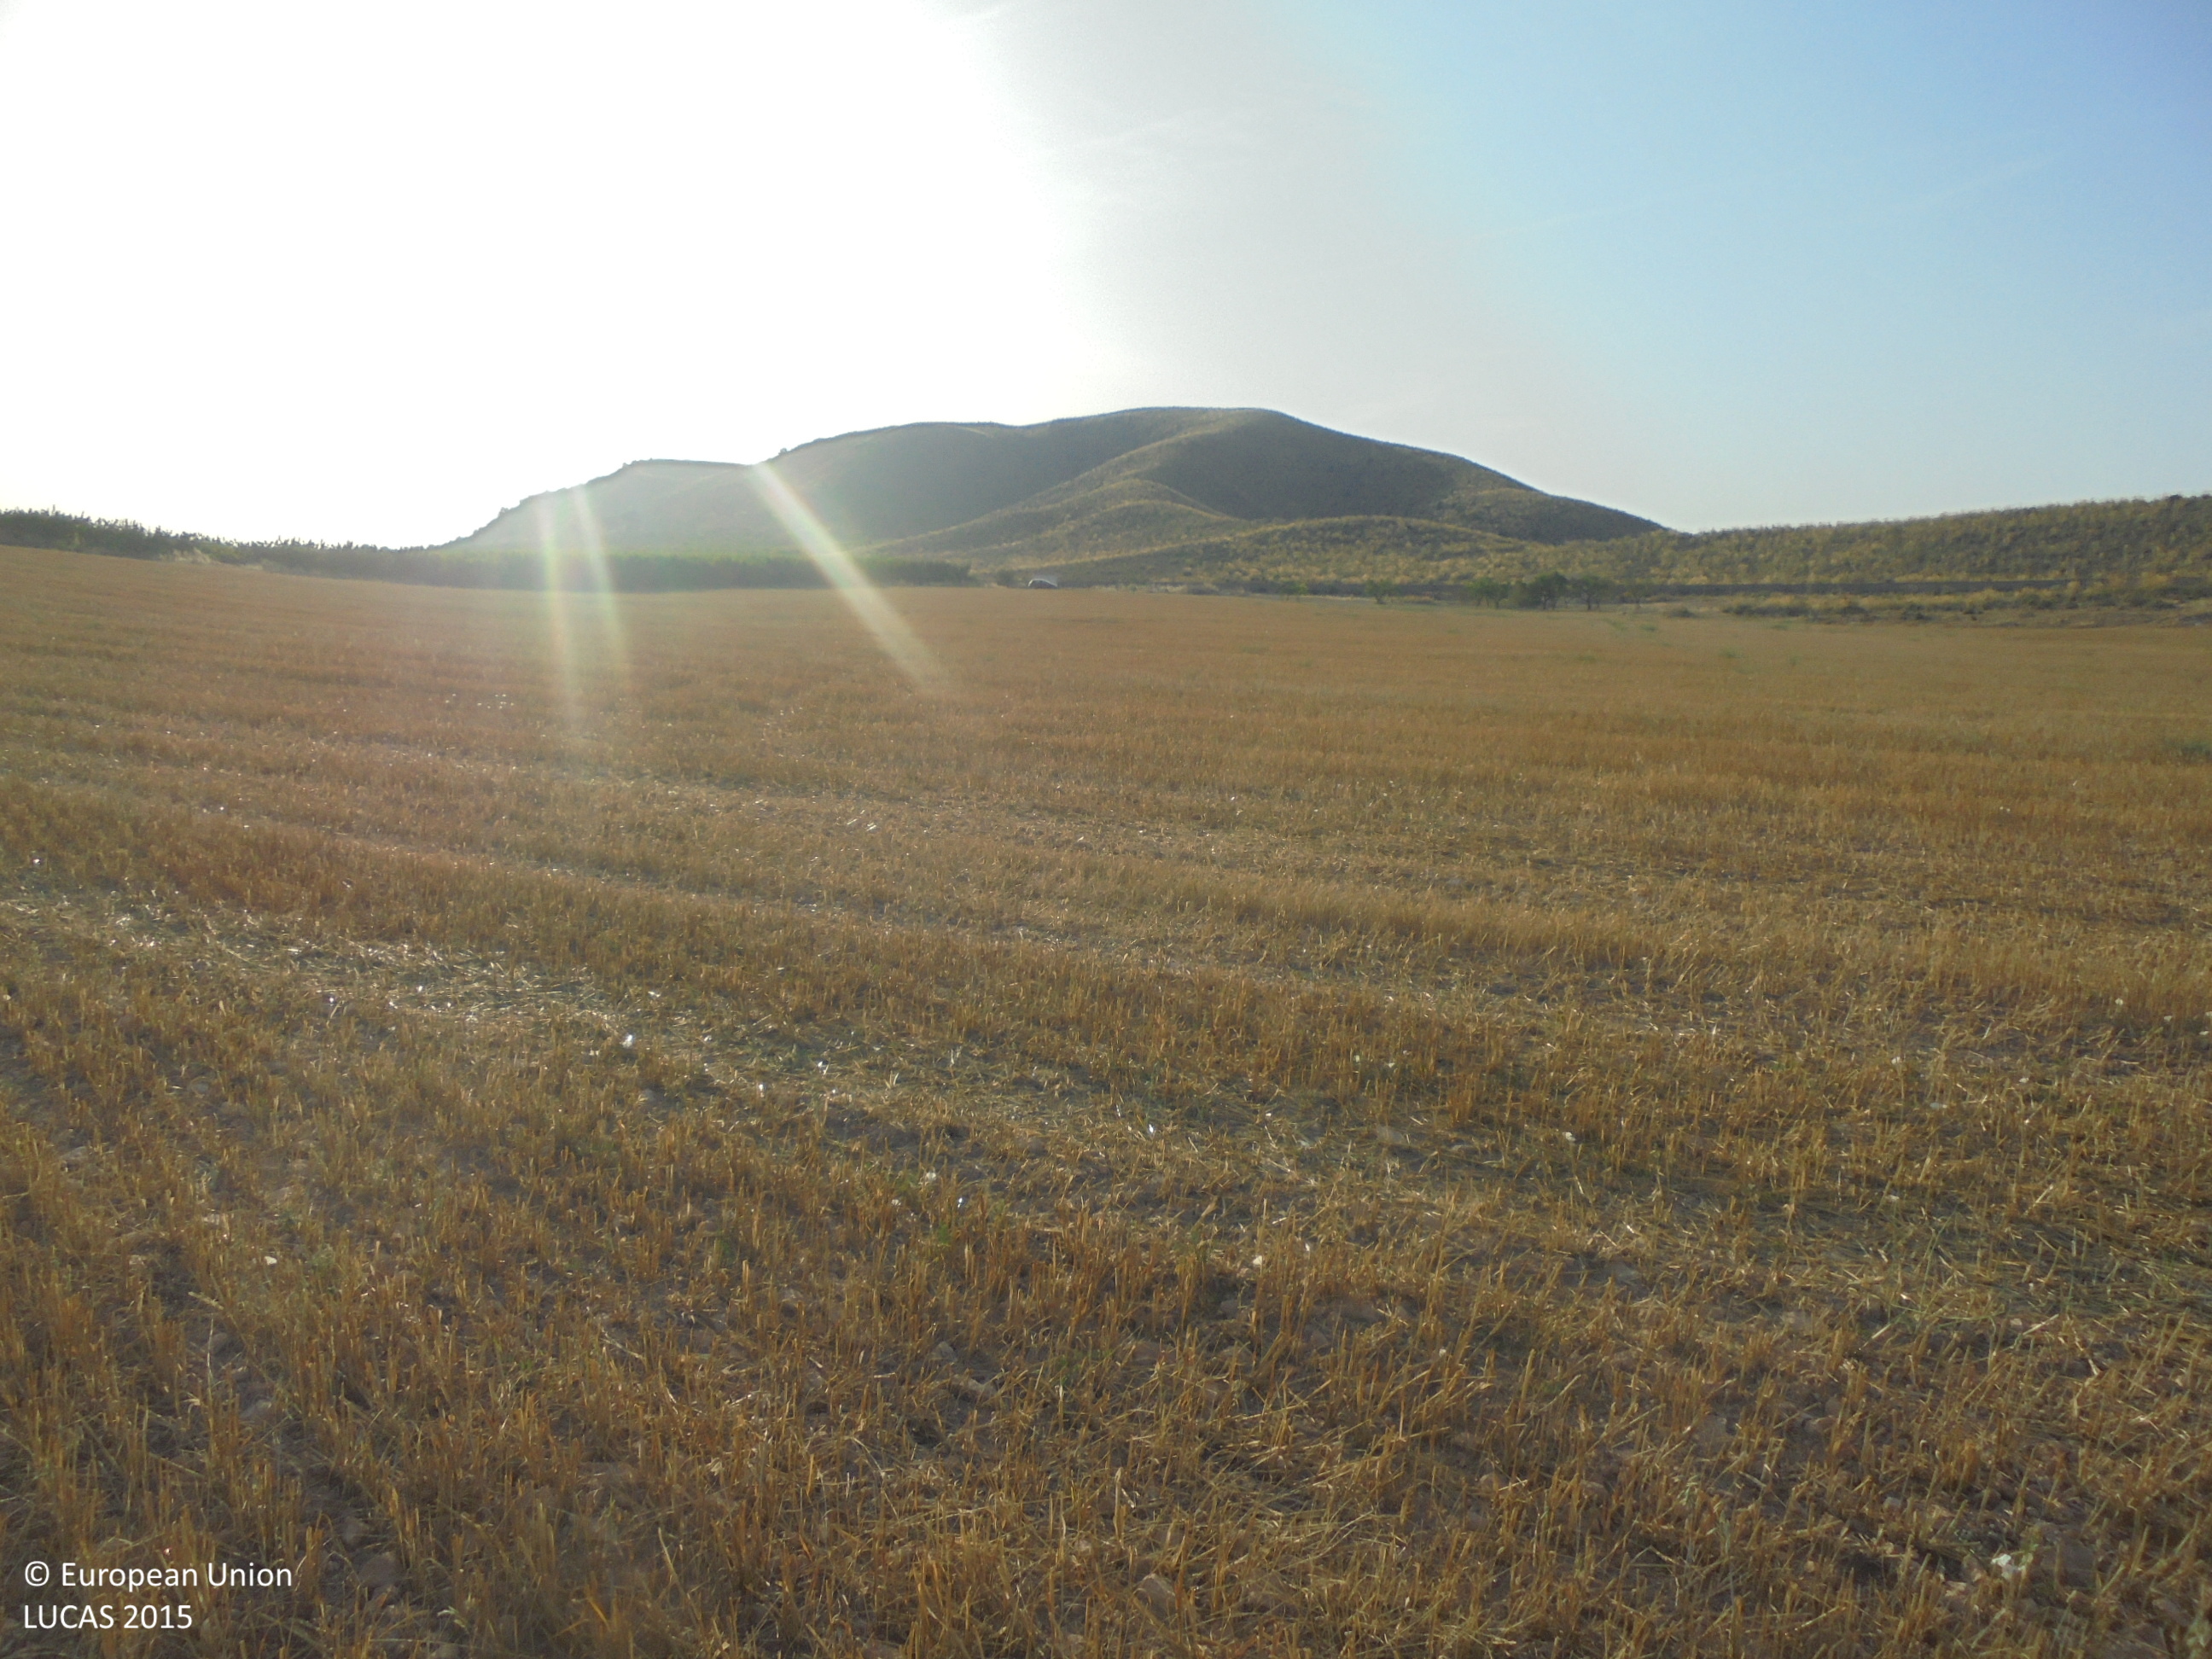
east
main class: Cropland
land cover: Oats
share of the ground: < 10 %
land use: Agriculture (excluding fallow land and kitchen gardens)
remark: Harvested field
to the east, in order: Oats; Grass margins; Tracks; Grass margins
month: July
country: ES
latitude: 38.6175
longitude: -1.6749
